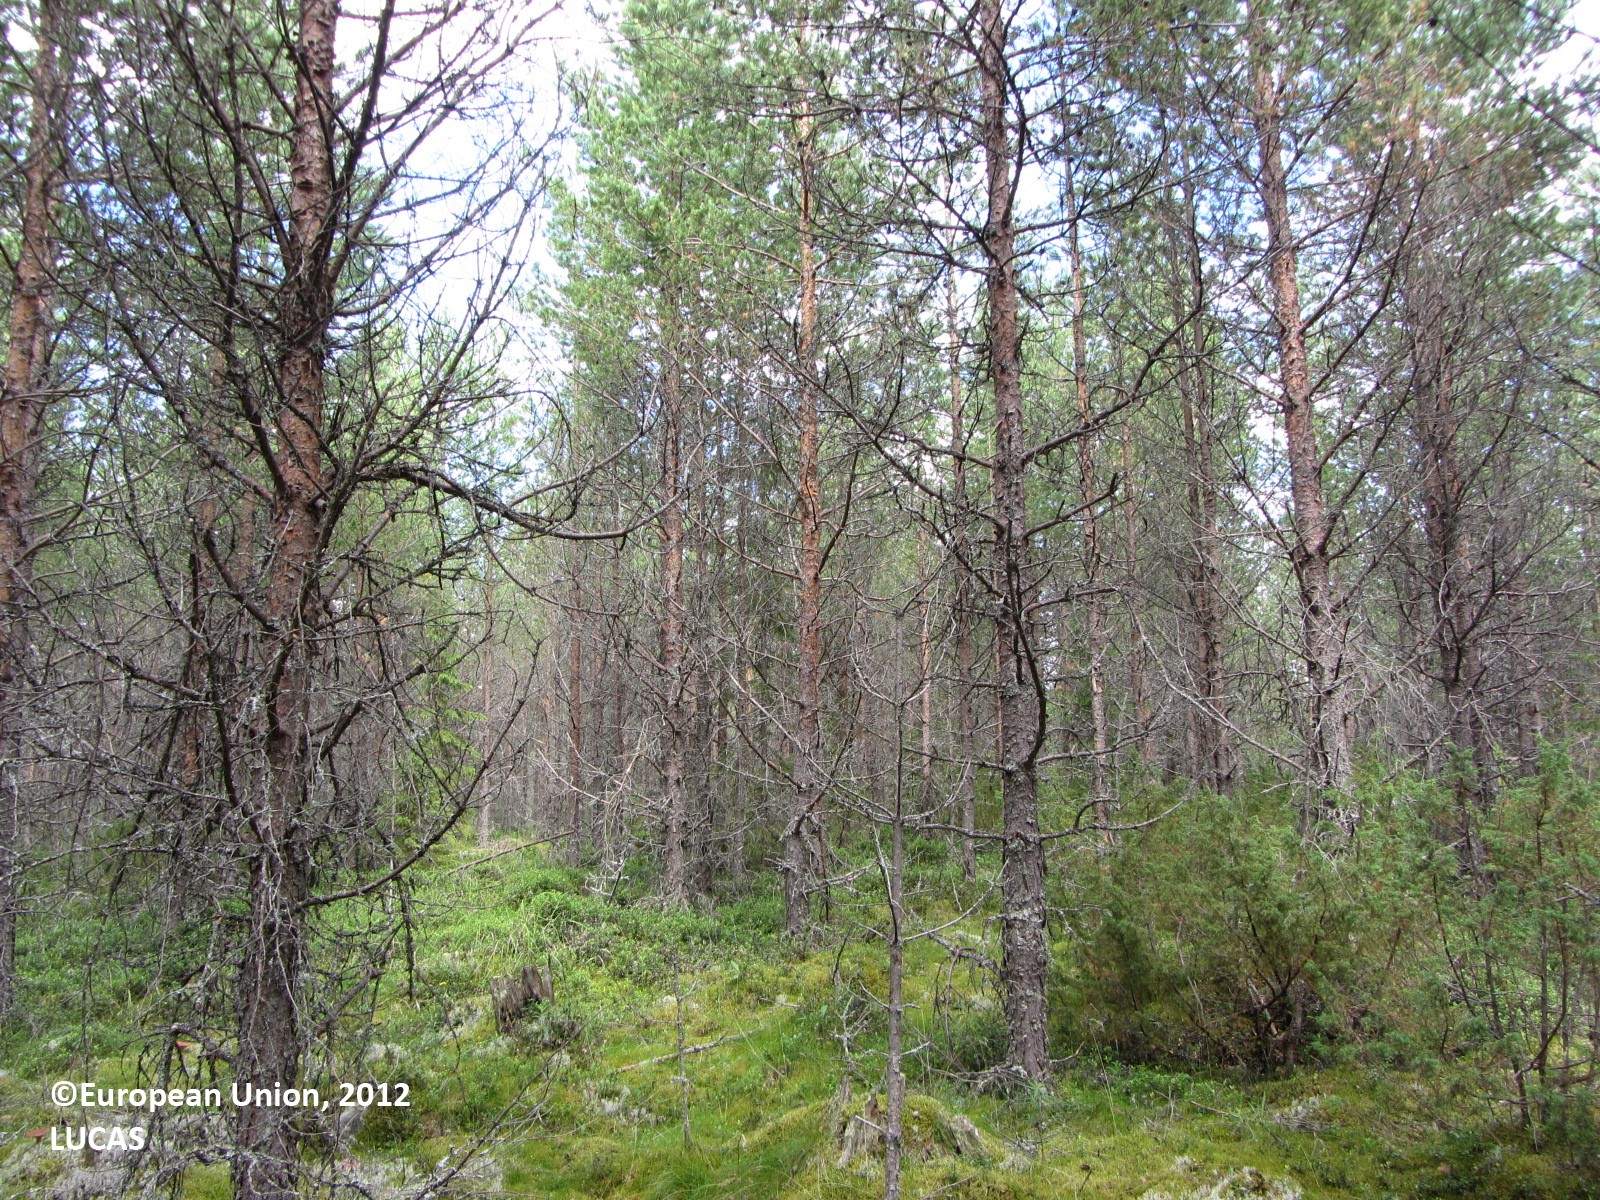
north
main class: Woodland
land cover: Pine dominated coniferous woodland
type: boreal forest
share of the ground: > 75 %
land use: Forestry
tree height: > 5 m
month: July
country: FI
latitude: 63.6029
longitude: 25.3997
